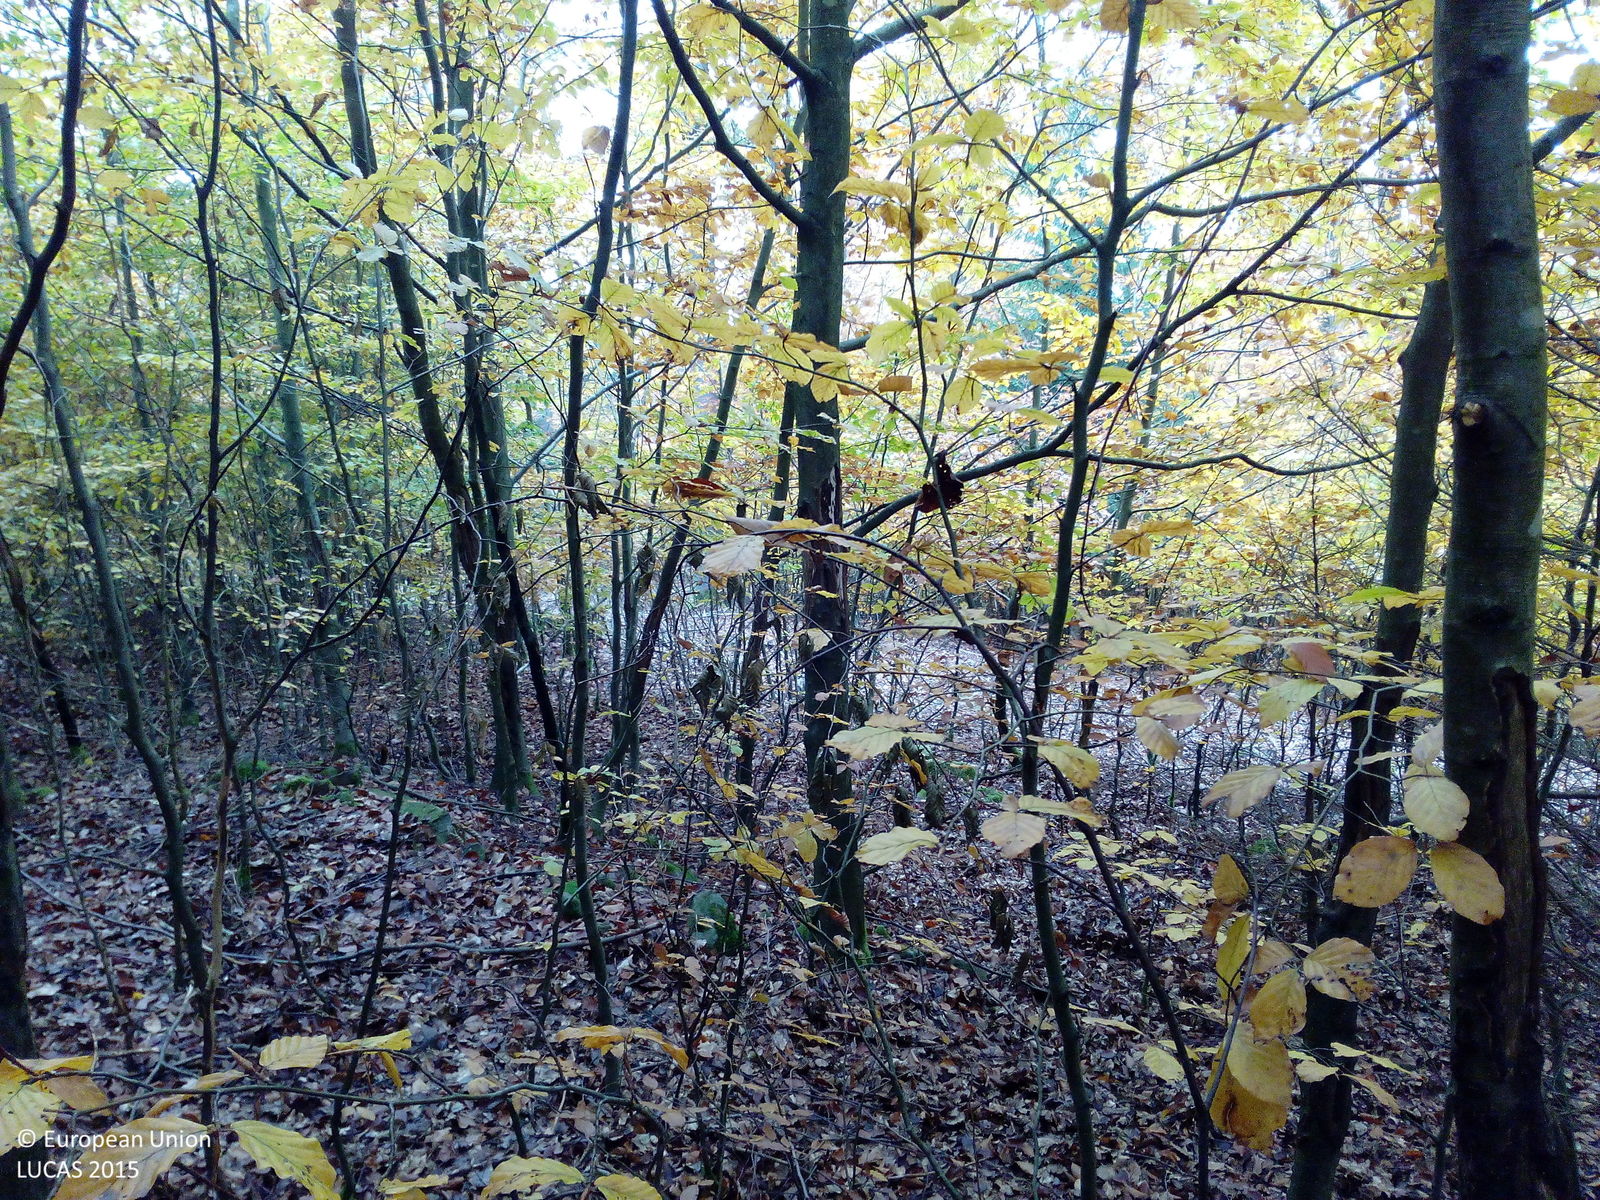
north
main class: Woodland
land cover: Broadleaved woodland
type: mesophytic deciduous forest
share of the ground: > 75 %
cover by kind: broadleaved forest trees 70 %, unconsolidated bare surface 15 %, coniferous forest trees 10 %, lichens and mosses 5 %
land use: Forestry
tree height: > 5 m
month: October
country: DE
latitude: 50.2561
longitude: 9.9019
